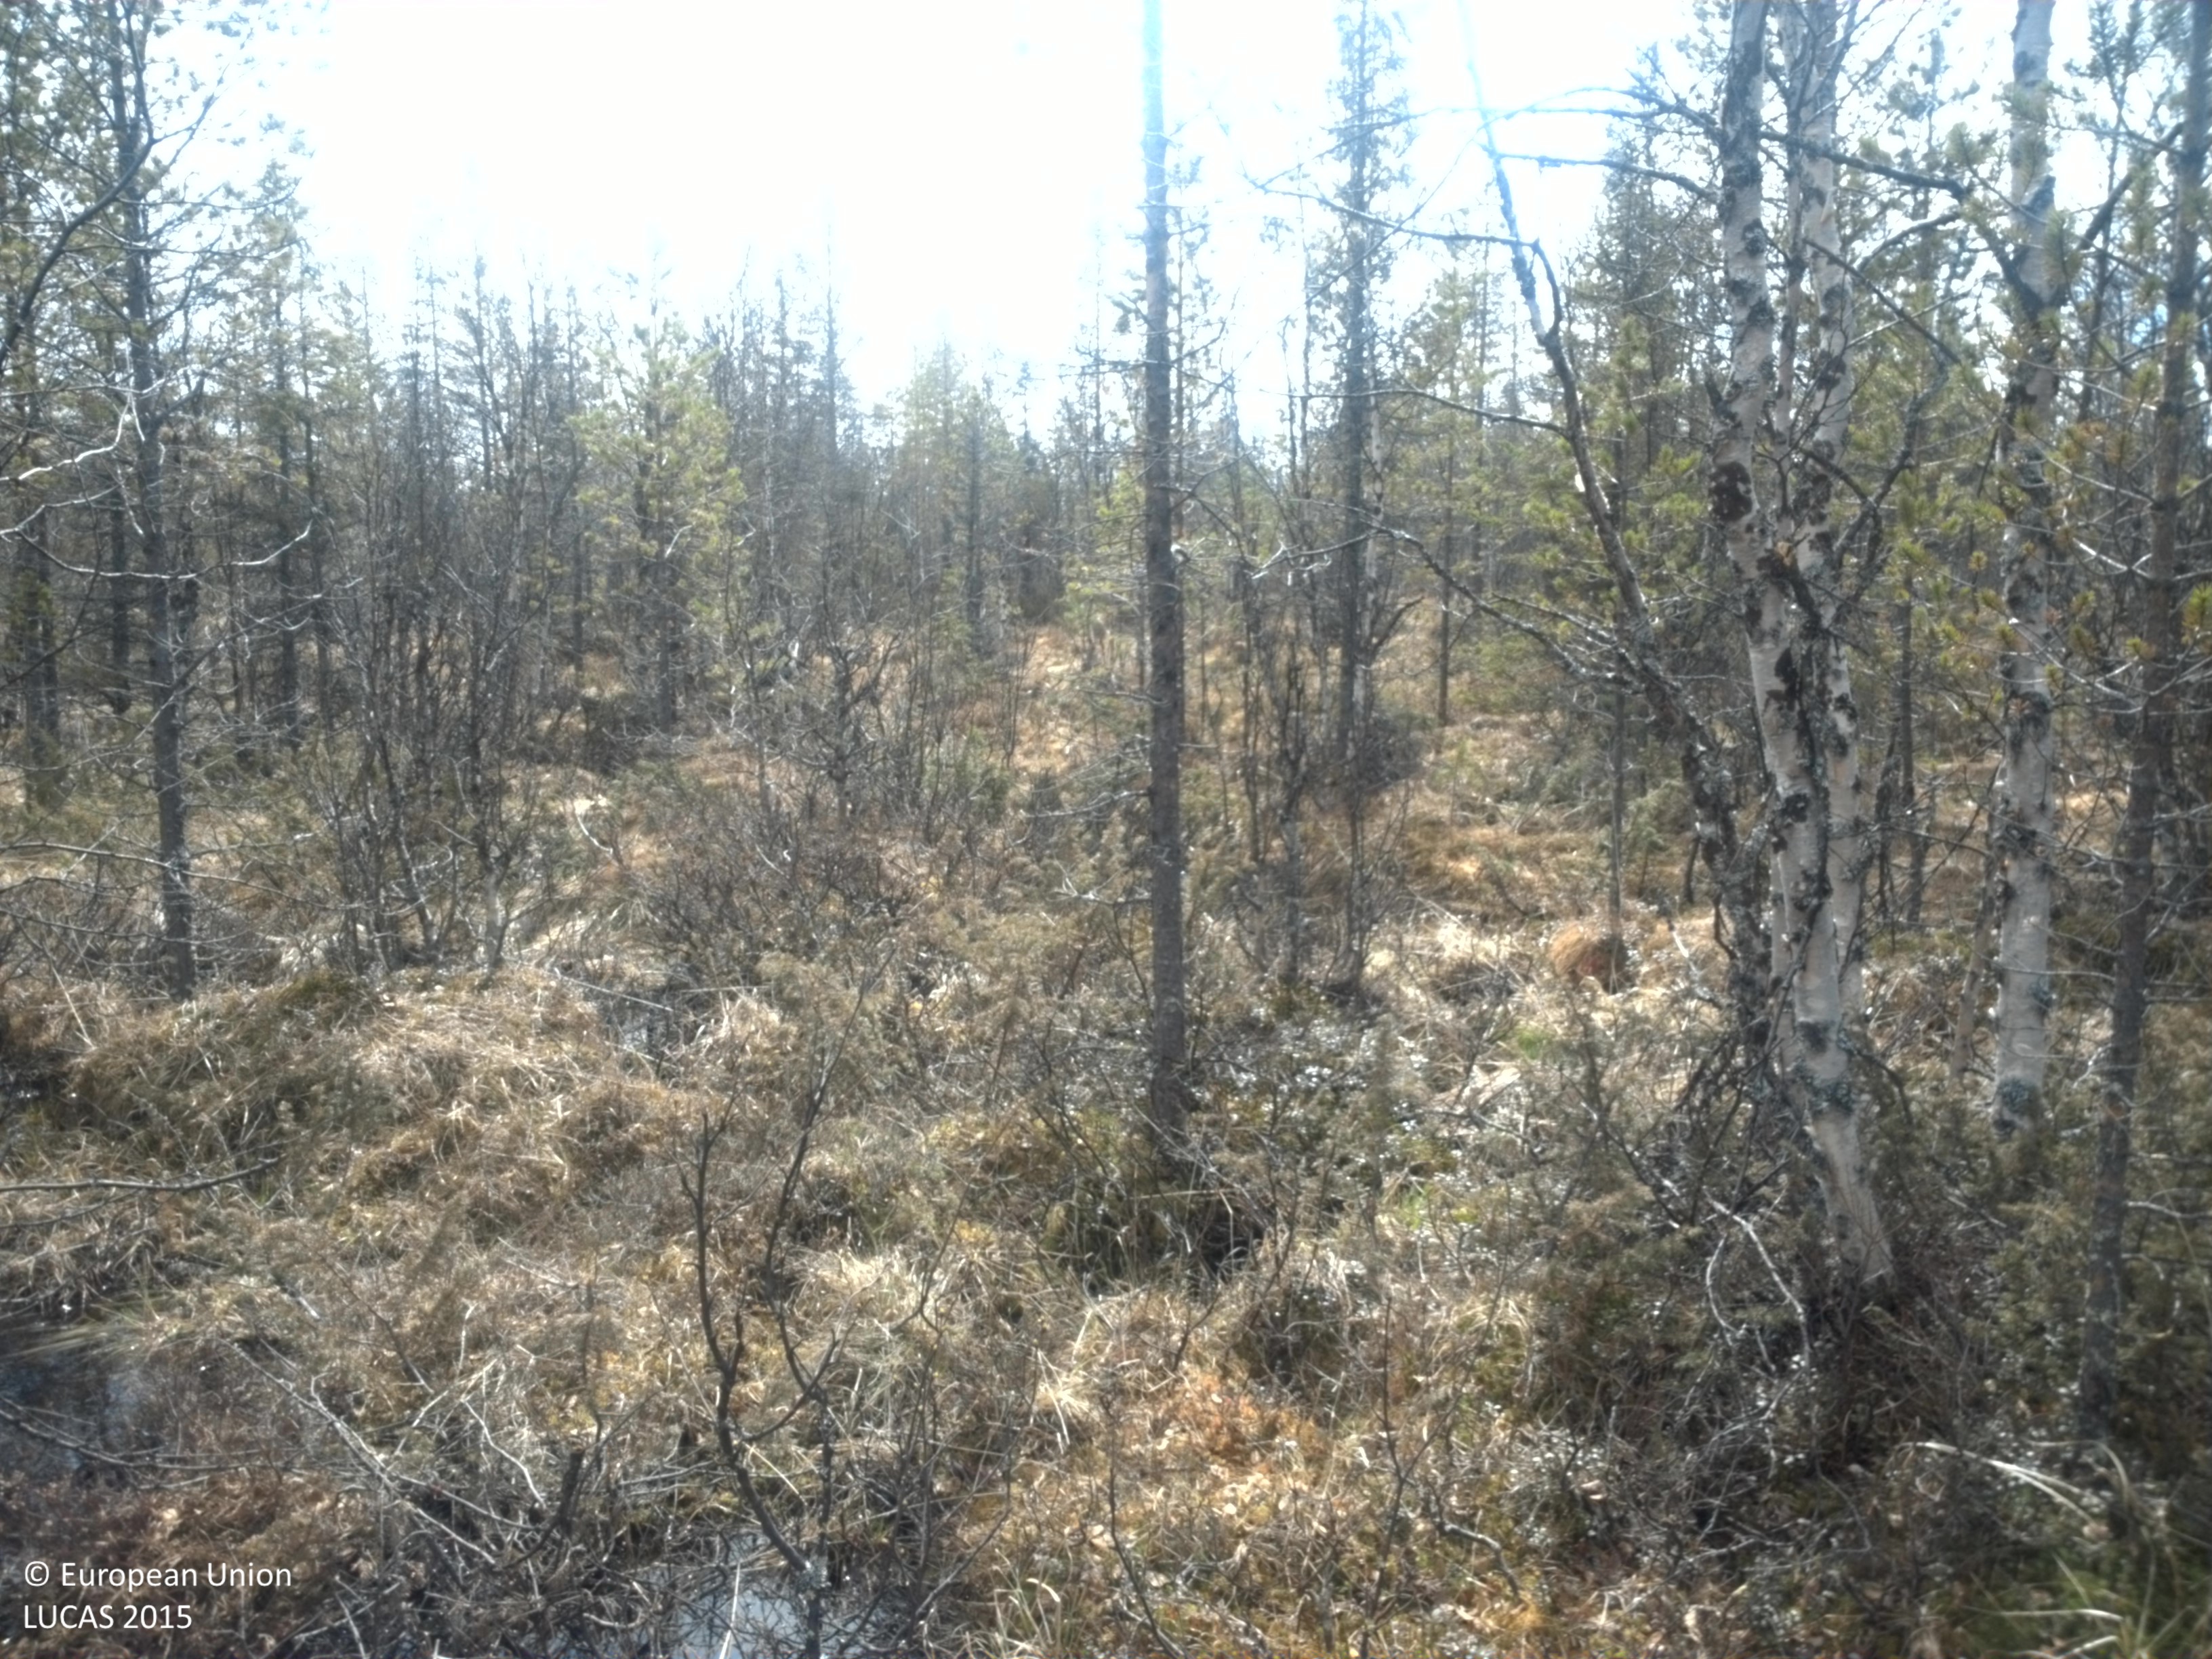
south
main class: Woodland
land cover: Pine dominated mixed woodland
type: boreal forest
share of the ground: 50 - 75 %
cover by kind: coniferous forest trees 50 %, shrubs 30 %, broadleaved forest trees 20 %
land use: Forestry
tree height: > 5 m
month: May
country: SE
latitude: 62.6909
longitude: 13.7928
